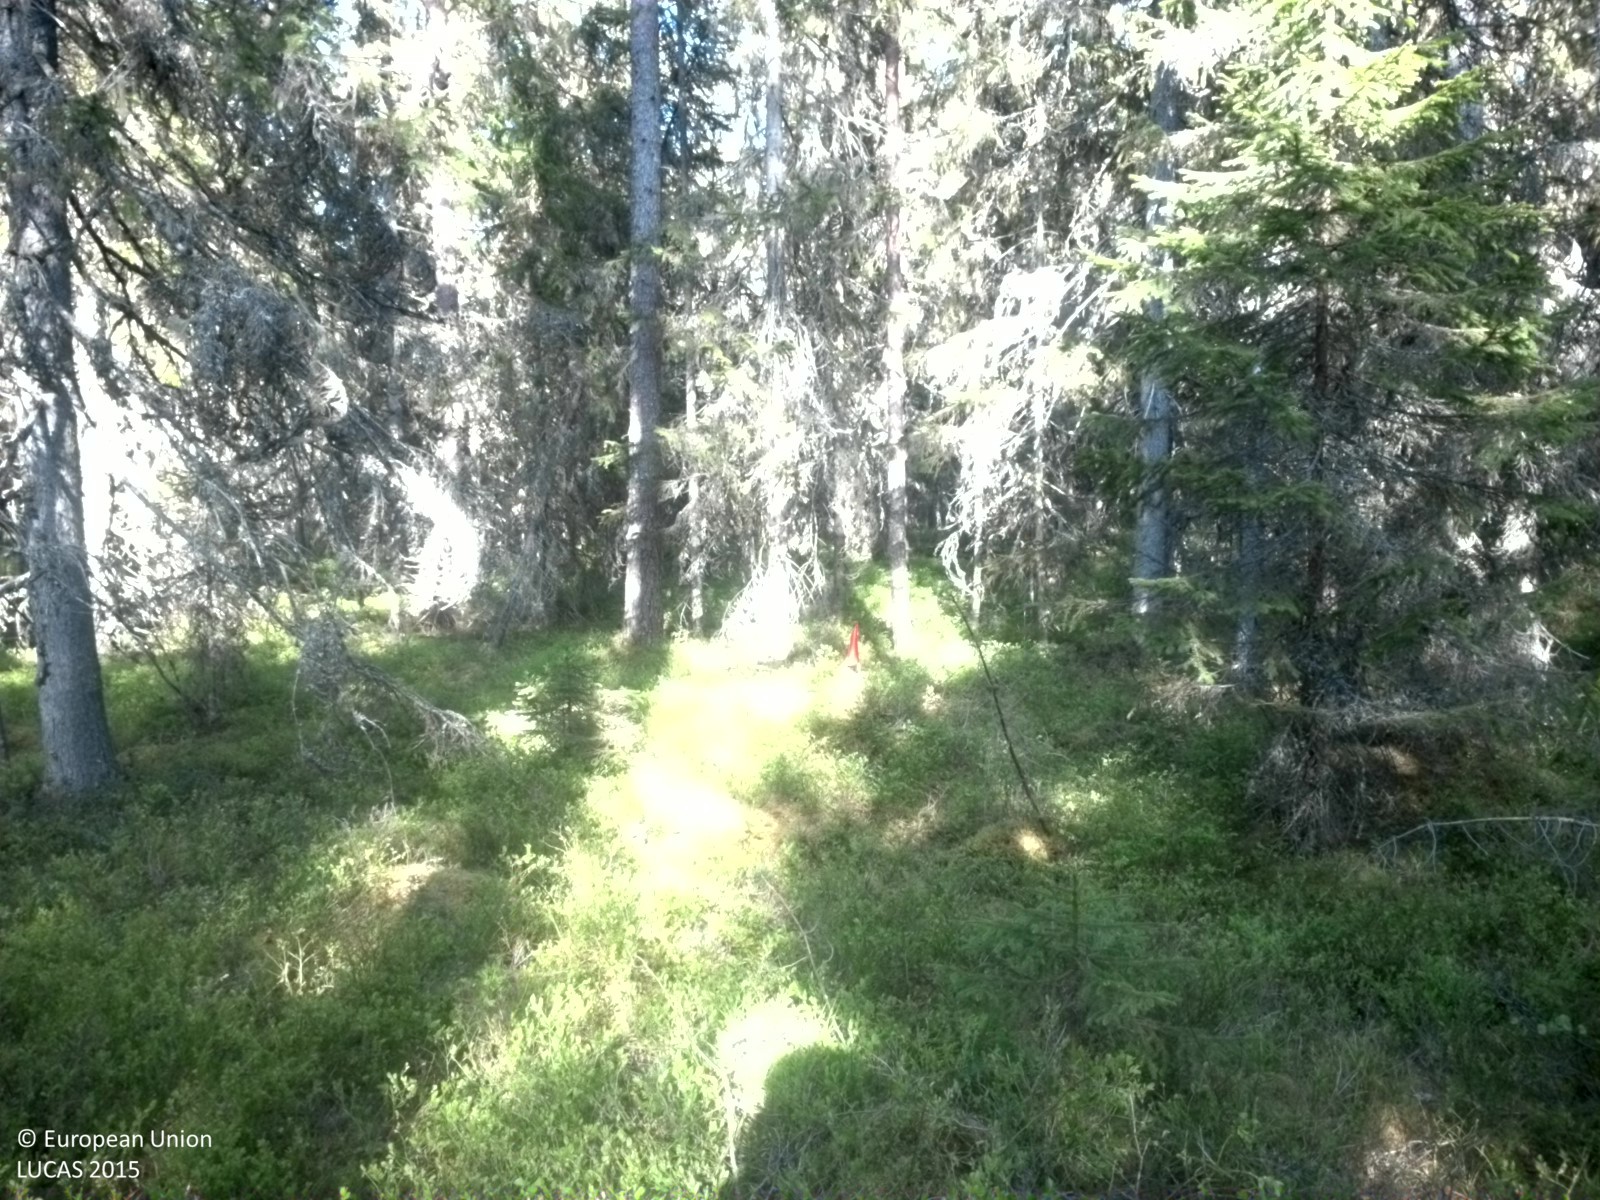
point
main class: Woodland
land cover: Spruce dominated coniferous woodland
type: boreal forest
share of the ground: 50 - 75 %
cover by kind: coniferous forest trees 55 %, shrubs 45 %
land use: Forestry
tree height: > 5 m
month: June
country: SE
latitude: 63.6992
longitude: 20.2795
